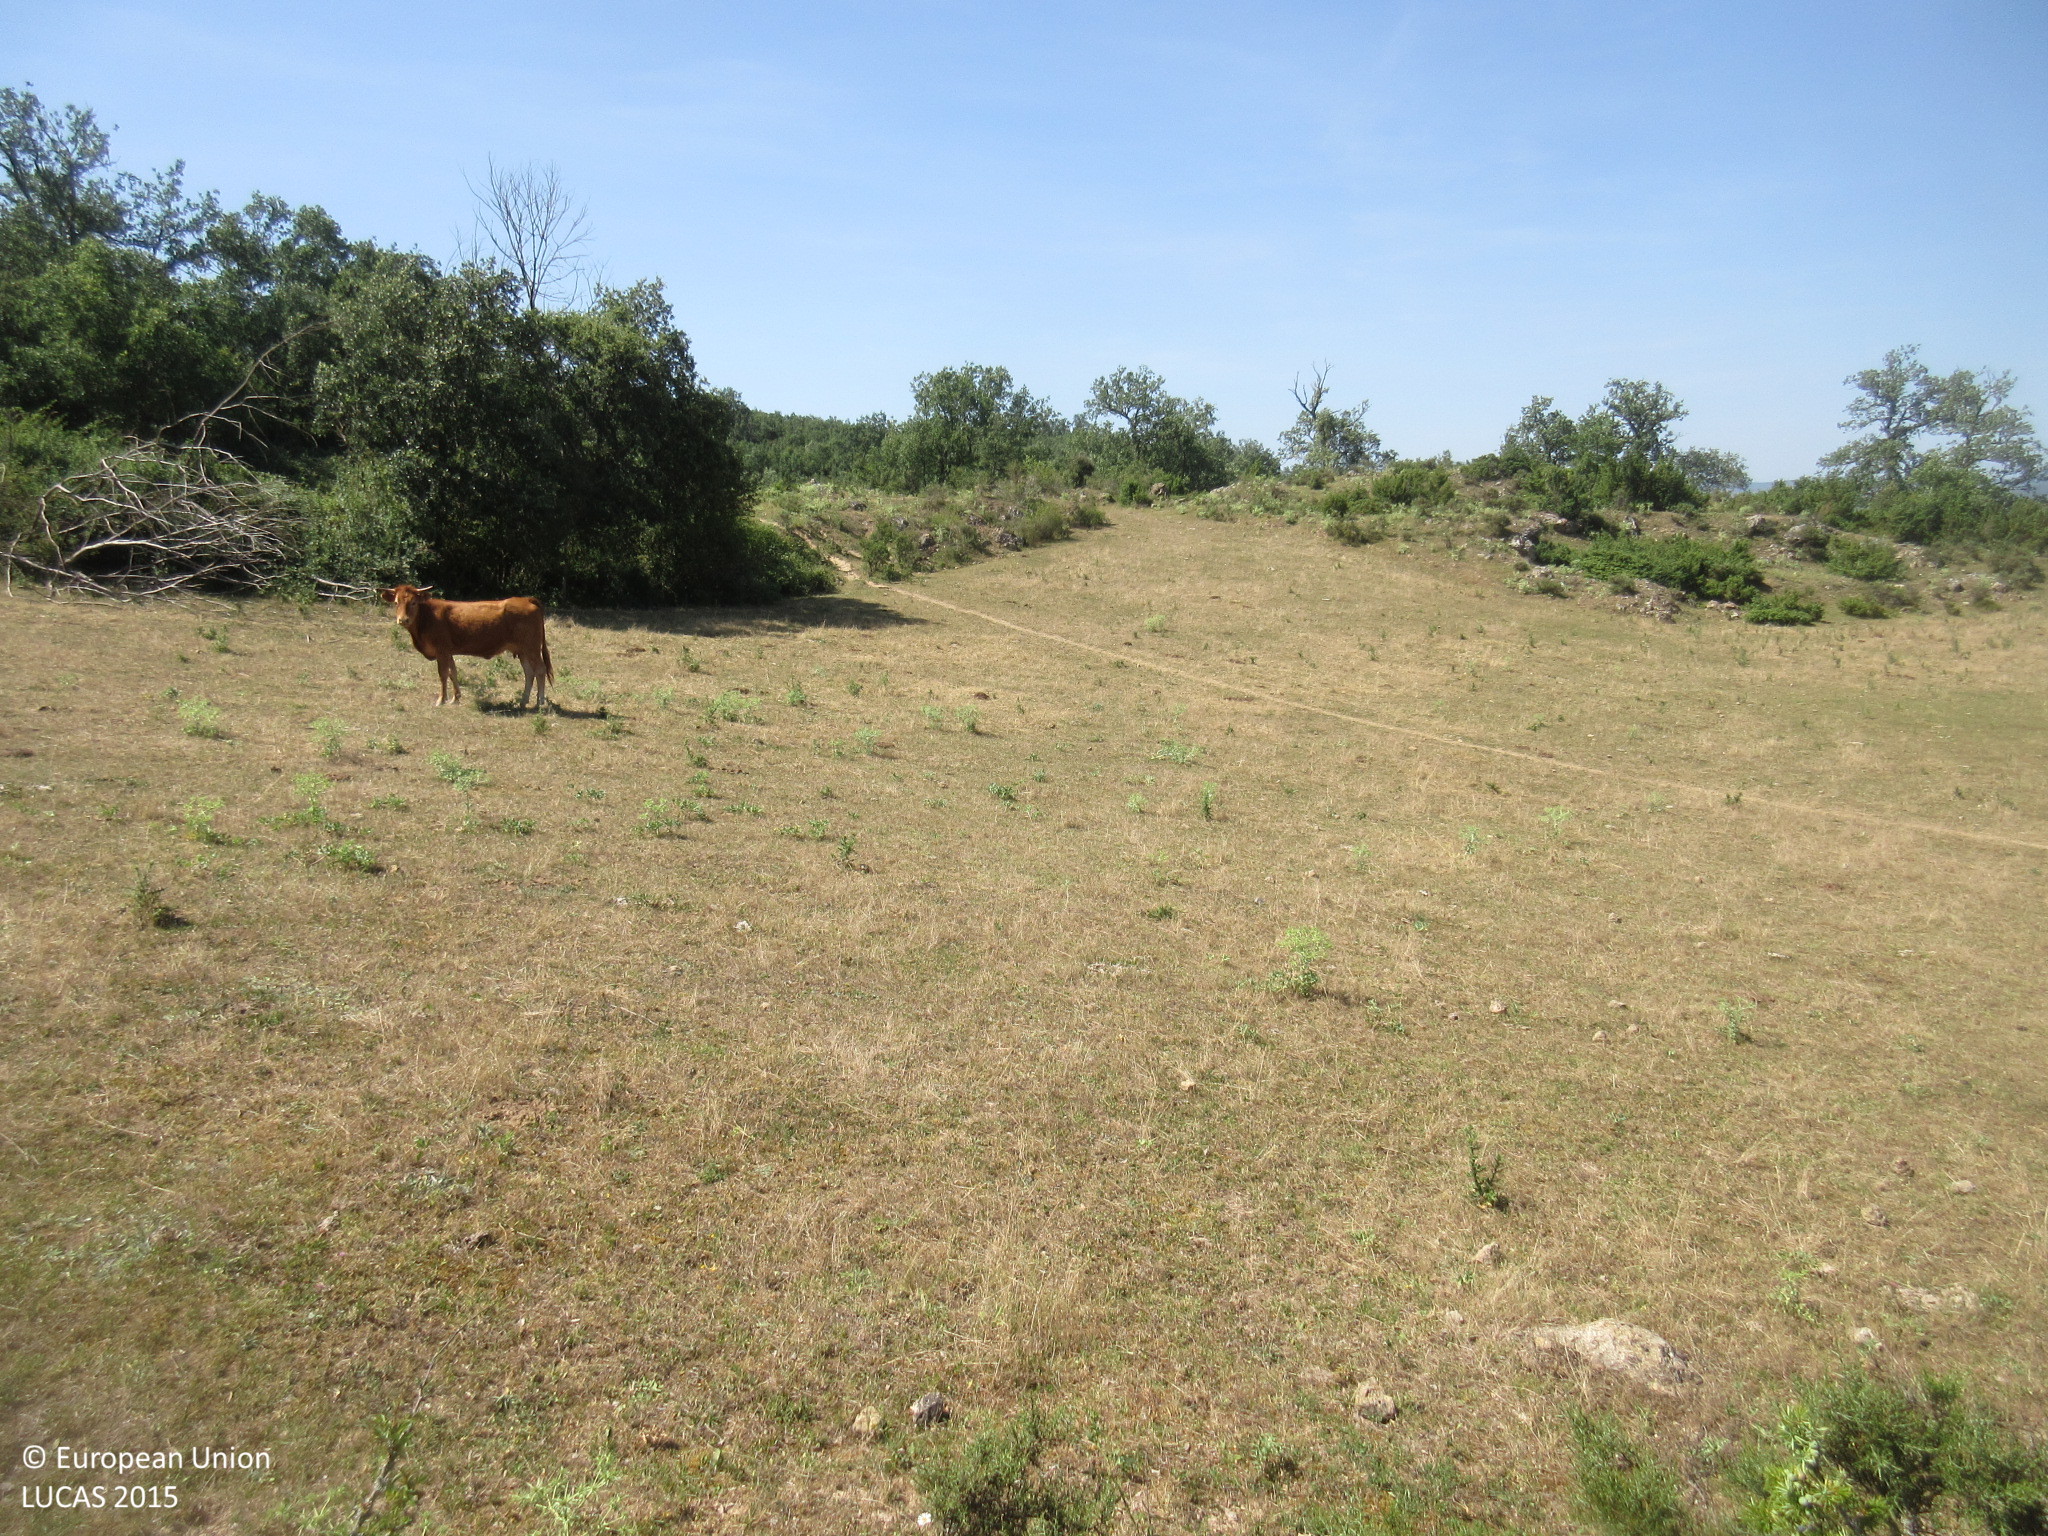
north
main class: Grassland
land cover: Grassland with sparse tree/shrub cover
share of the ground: > 75 %
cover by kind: herbaceous plants 90 %, broadleaved forest trees 5 %, shrubs 5 %
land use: Agriculture (excluding fallow land and kitchen gardens)
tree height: > 5 m
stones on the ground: 10 - 25 %
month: July
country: ES
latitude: 42.9427
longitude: -3.4334
